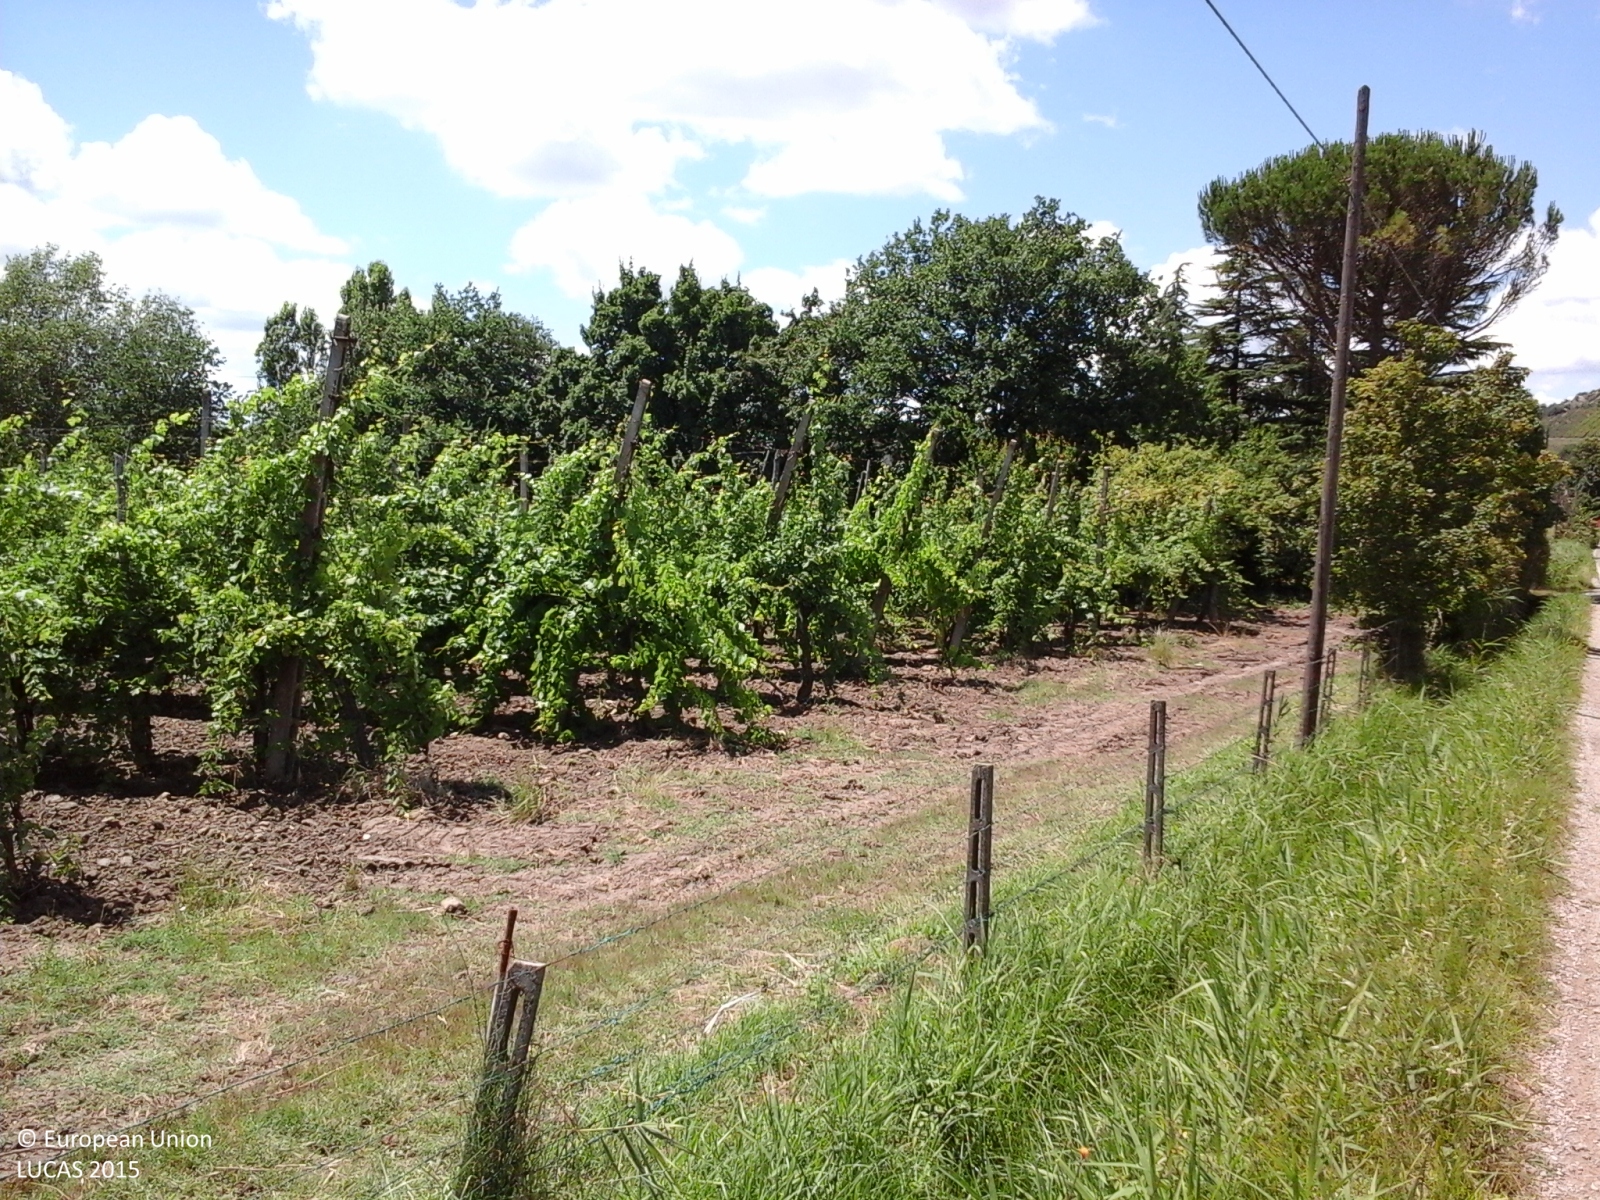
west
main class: Artificial land
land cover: Non built-up linear features
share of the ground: > 75 %
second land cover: Grassland without tree/shrub cover
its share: > 75 %
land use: Road transport
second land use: Agriculture (excluding fallow land and kitchen gardens)
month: June
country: IT
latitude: 44.3015
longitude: 11.6383
